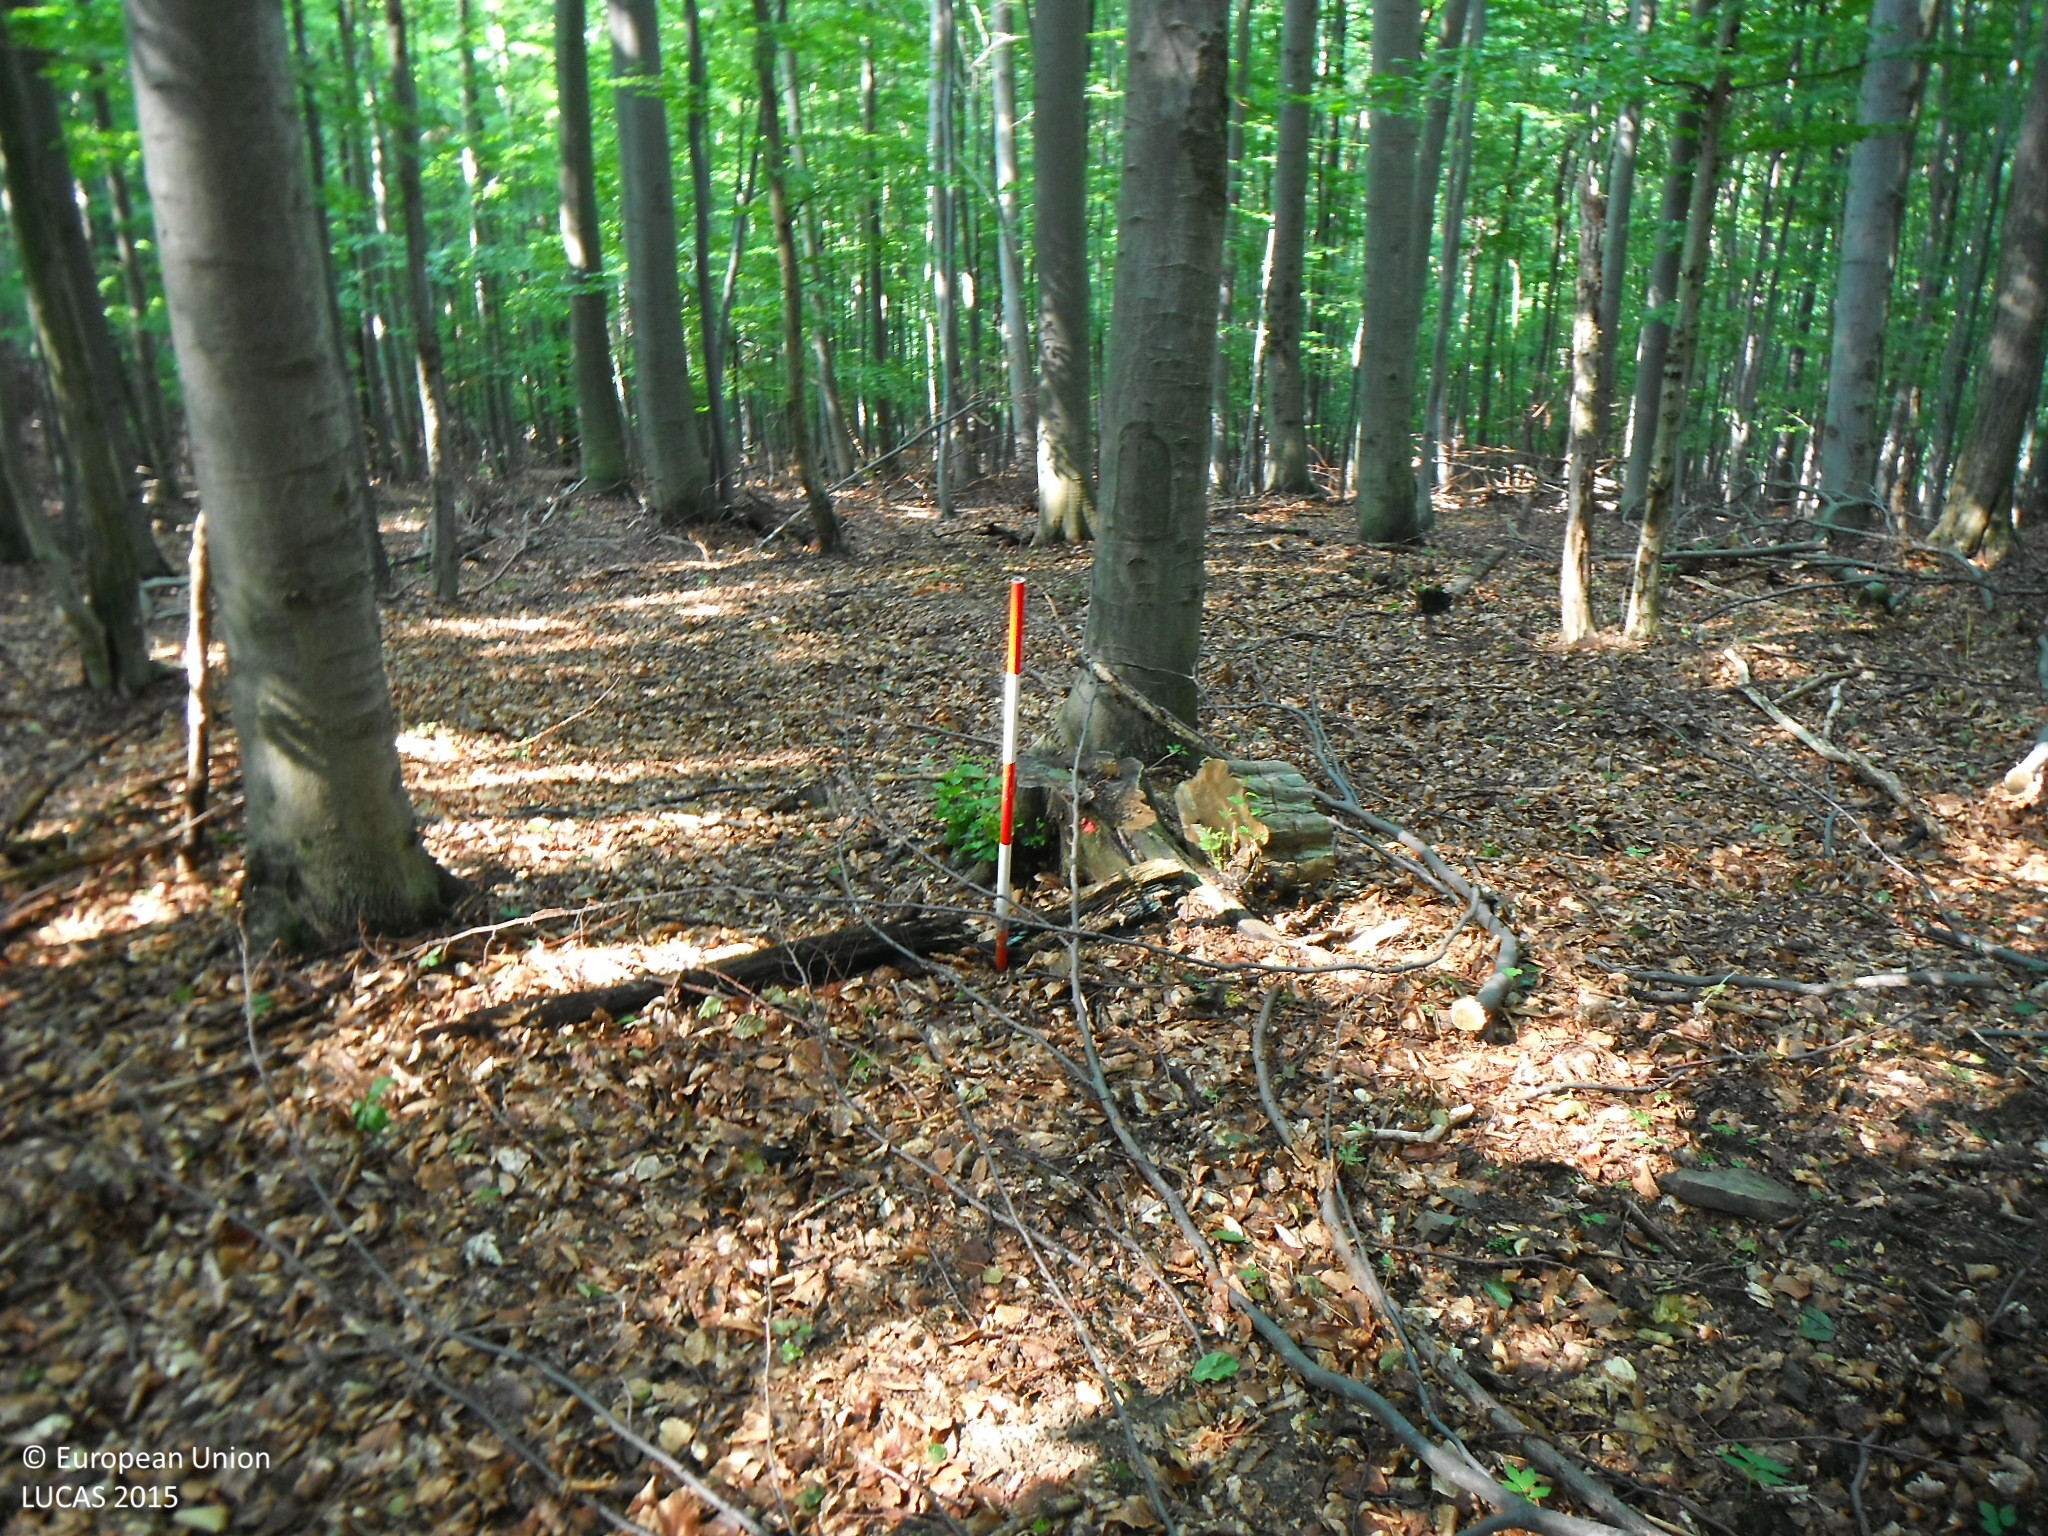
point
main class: Woodland
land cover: Broadleaved woodland
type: beech forest
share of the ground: > 75 %
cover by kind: broadleaved forest trees 95 %, herbaceous plants 5 %
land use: Forestry
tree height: > 5 m
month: July
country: SK
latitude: 49.3870
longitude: 21.2738
